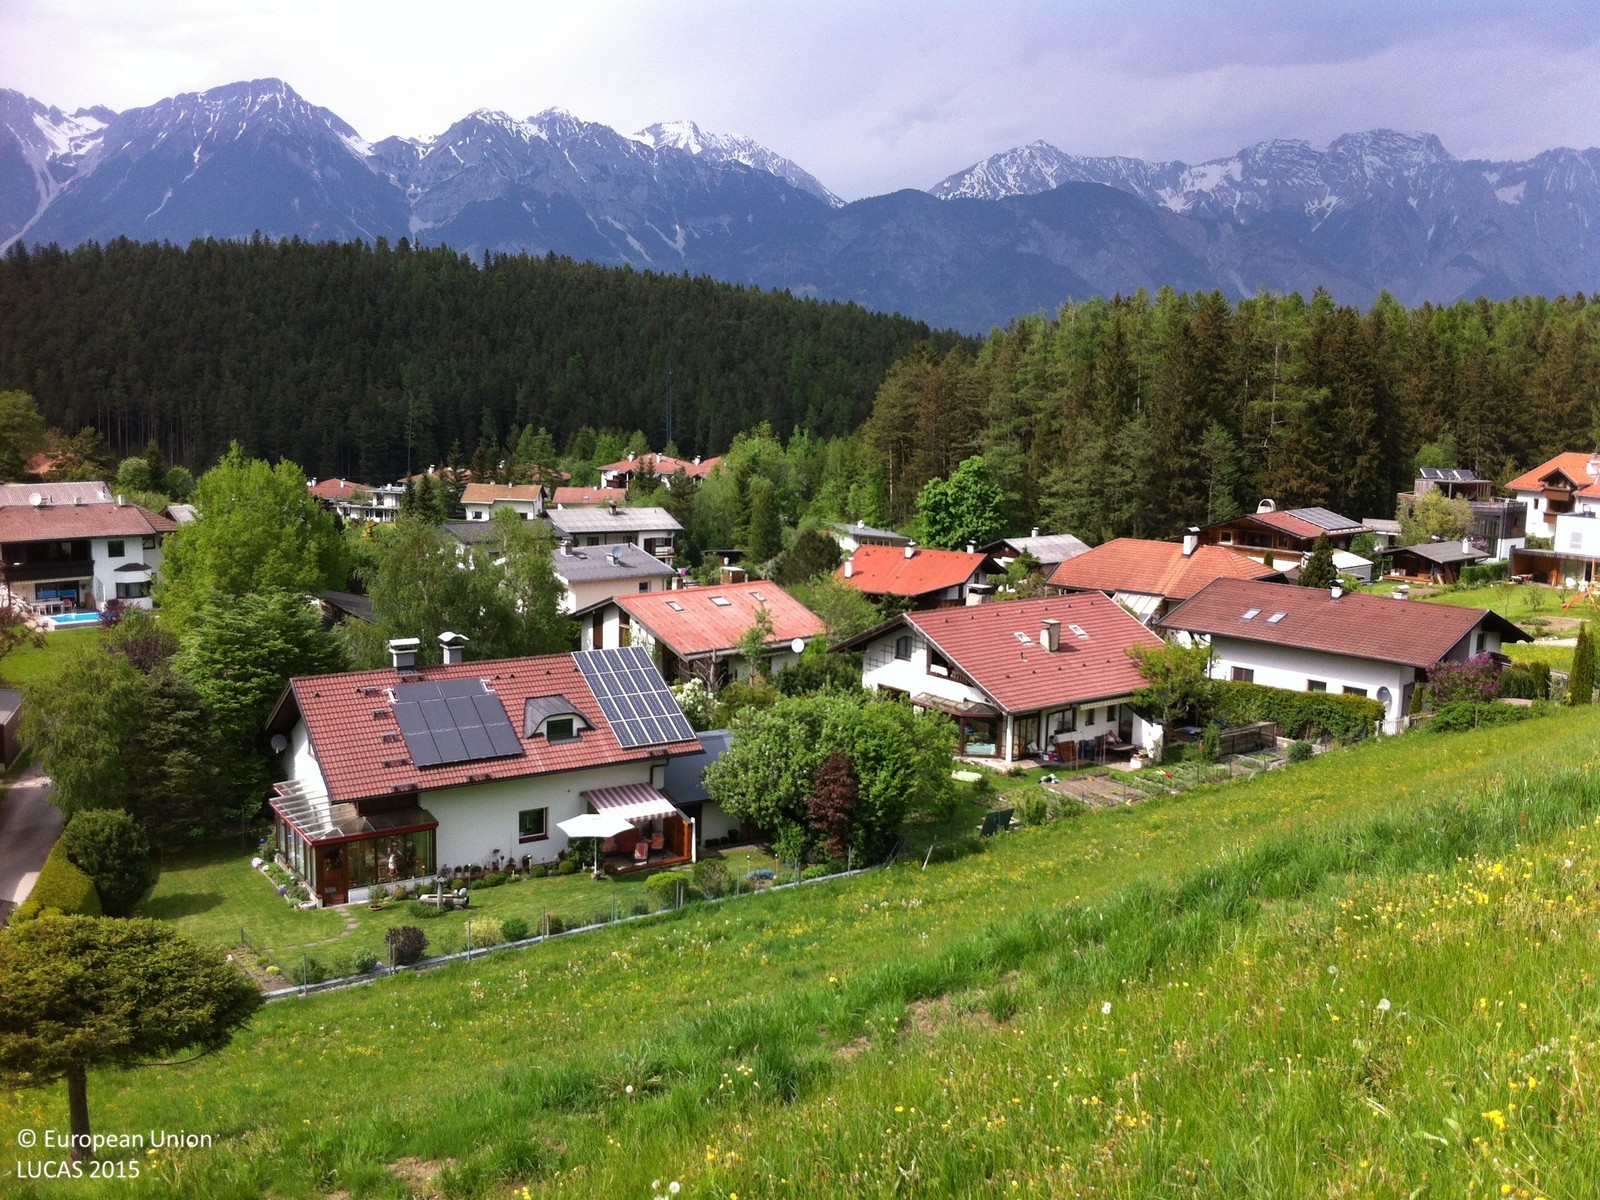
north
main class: Grassland
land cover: Grassland without tree/shrub cover
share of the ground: > 75 %
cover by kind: herbaceous plants 100 %
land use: Agriculture (excluding fallow land and kitchen gardens)
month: May
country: AT
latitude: 47.2417
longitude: 11.4650
